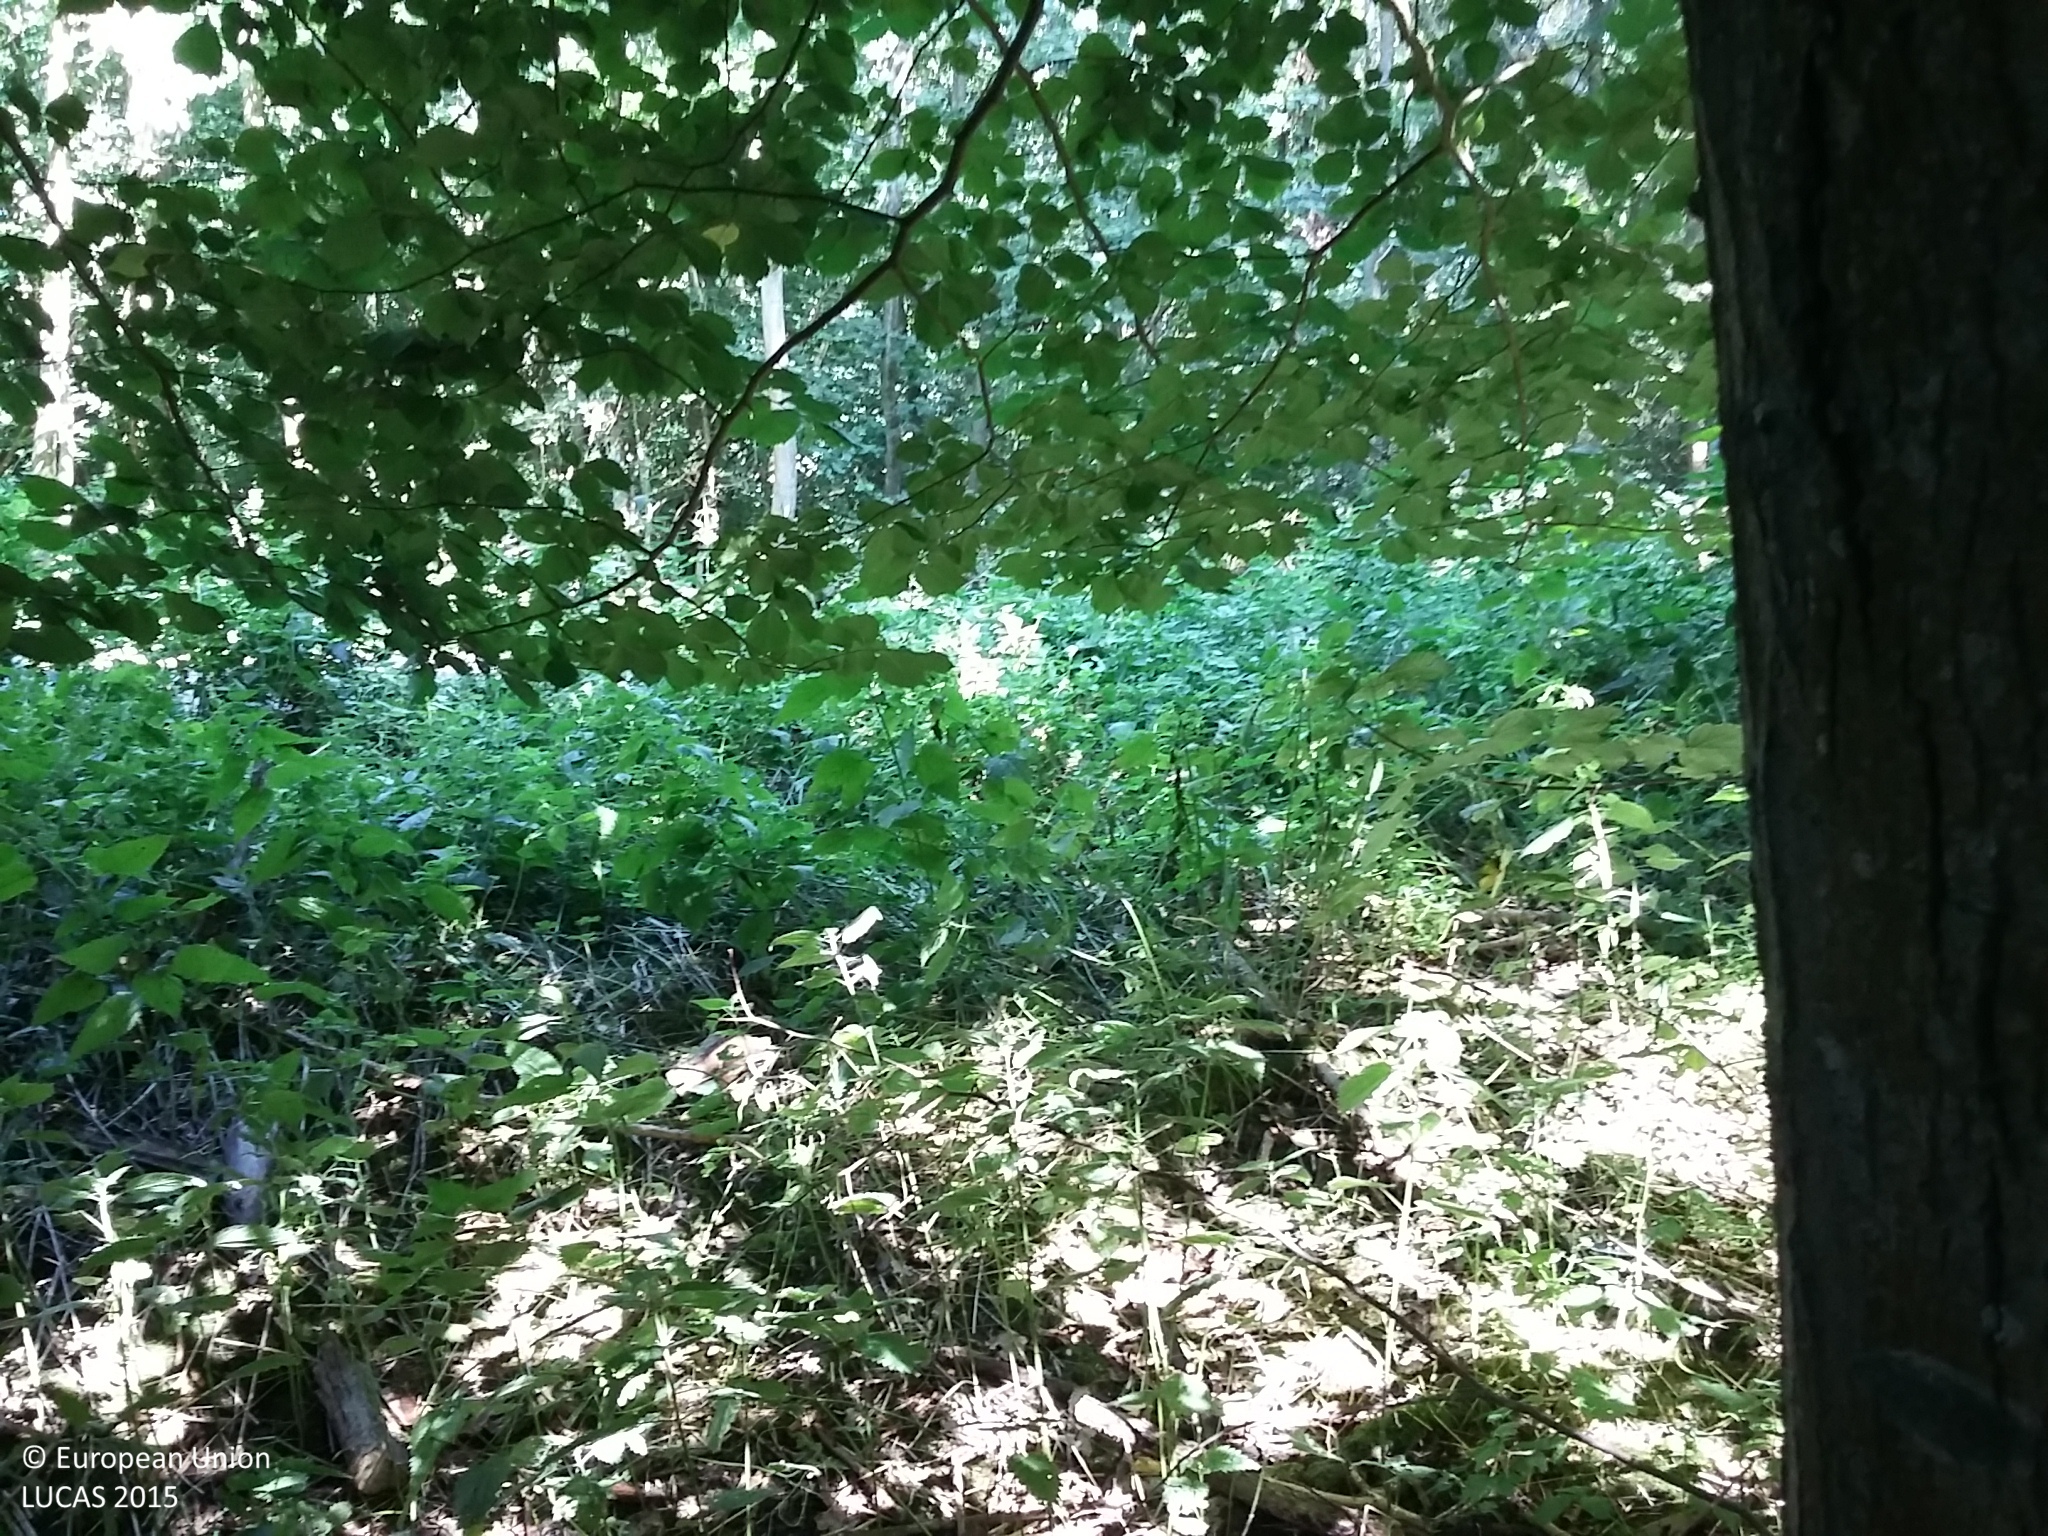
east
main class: Woodland
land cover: Broadleaved woodland
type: beech forest
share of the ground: > 75 %
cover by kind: broadleaved forest trees 80 %, herbaceous plants 20 %
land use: Forestry
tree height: > 5 m
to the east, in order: Broadleaved woodland; Paved roads, cycling and walking lanes; Grass margins; Ditches and canals; Dry stone walls; Broadleaved woodland; Dry stone walls; Fences; Grassland without tree/shrub cover; Fences; Grassland without tree/shrub cover; Fences; Grassland without tree/shrub cover; Broadleaved woodland
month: August
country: DK
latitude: 55.0915
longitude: 14.7476
